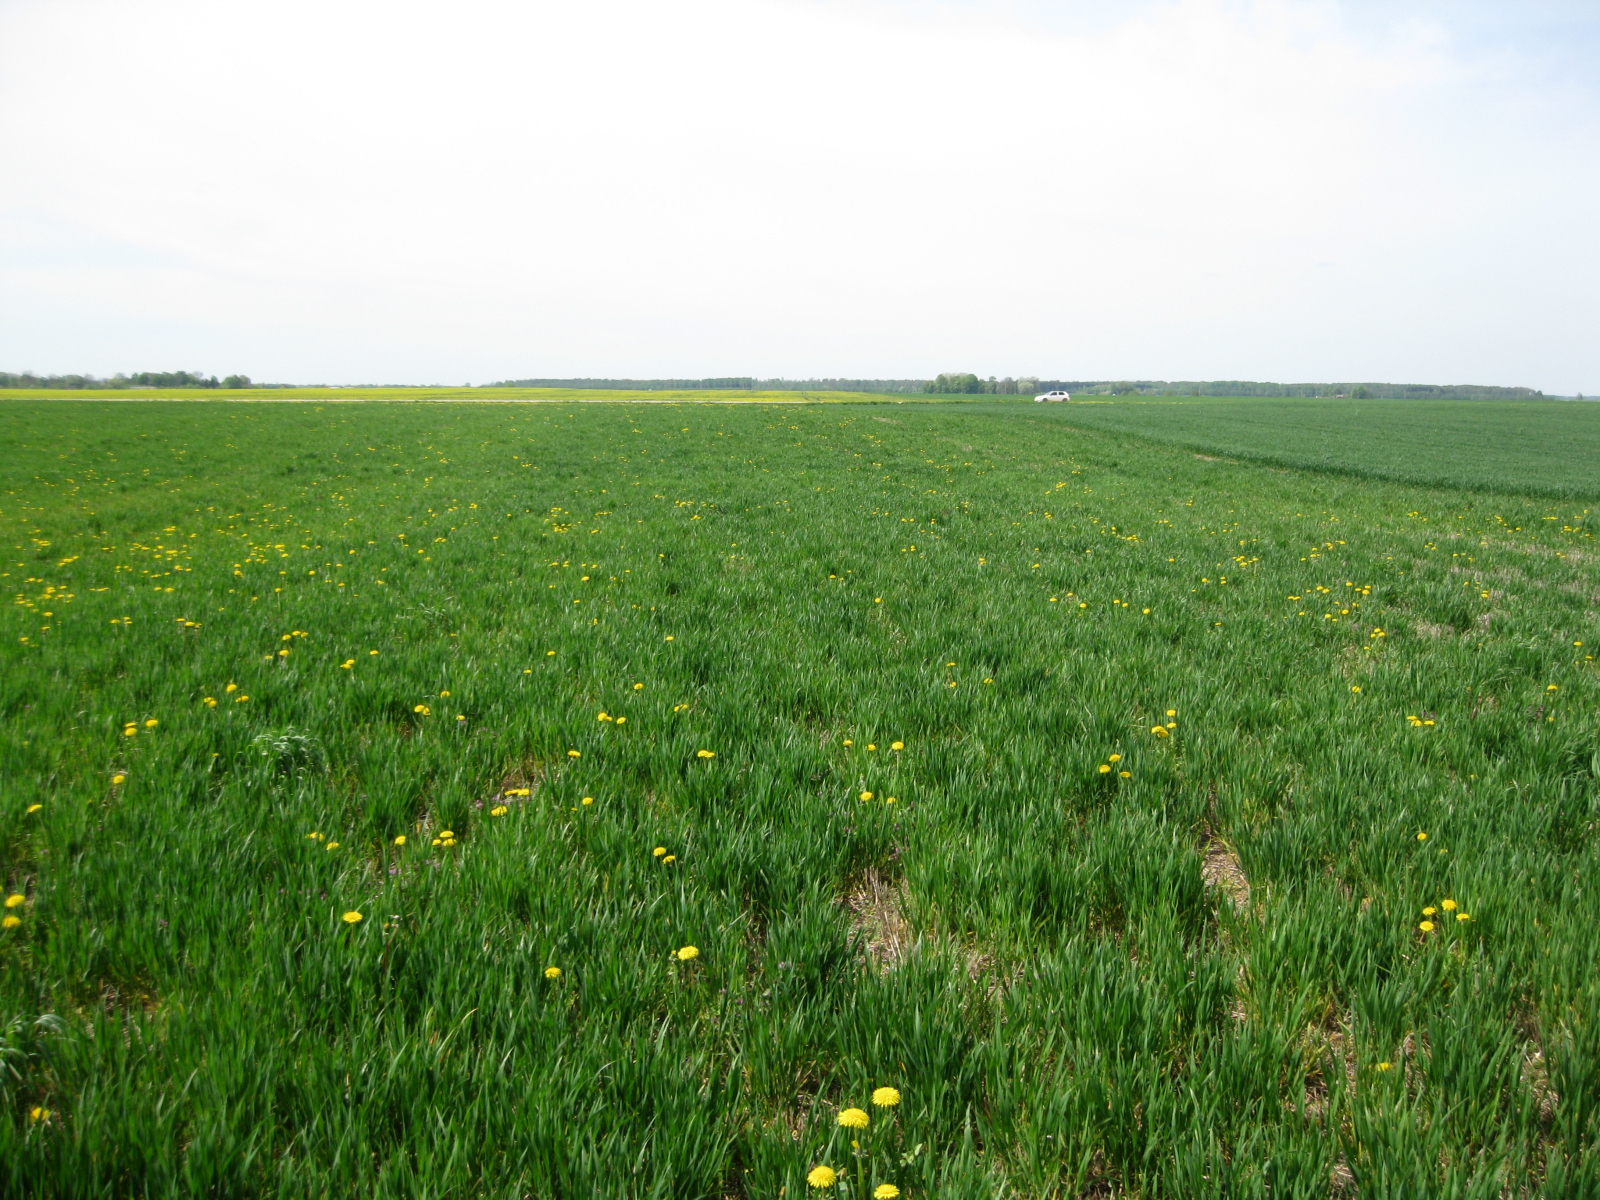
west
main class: Grassland
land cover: Grassland without tree/shrub cover
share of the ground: > 75 %
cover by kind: herbaceous plants 90 %, consolidated bare surface 10 %
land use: Agriculture (excluding fallow land and kitchen gardens)
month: May
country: LT
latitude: 56.2331
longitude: 24.2063
